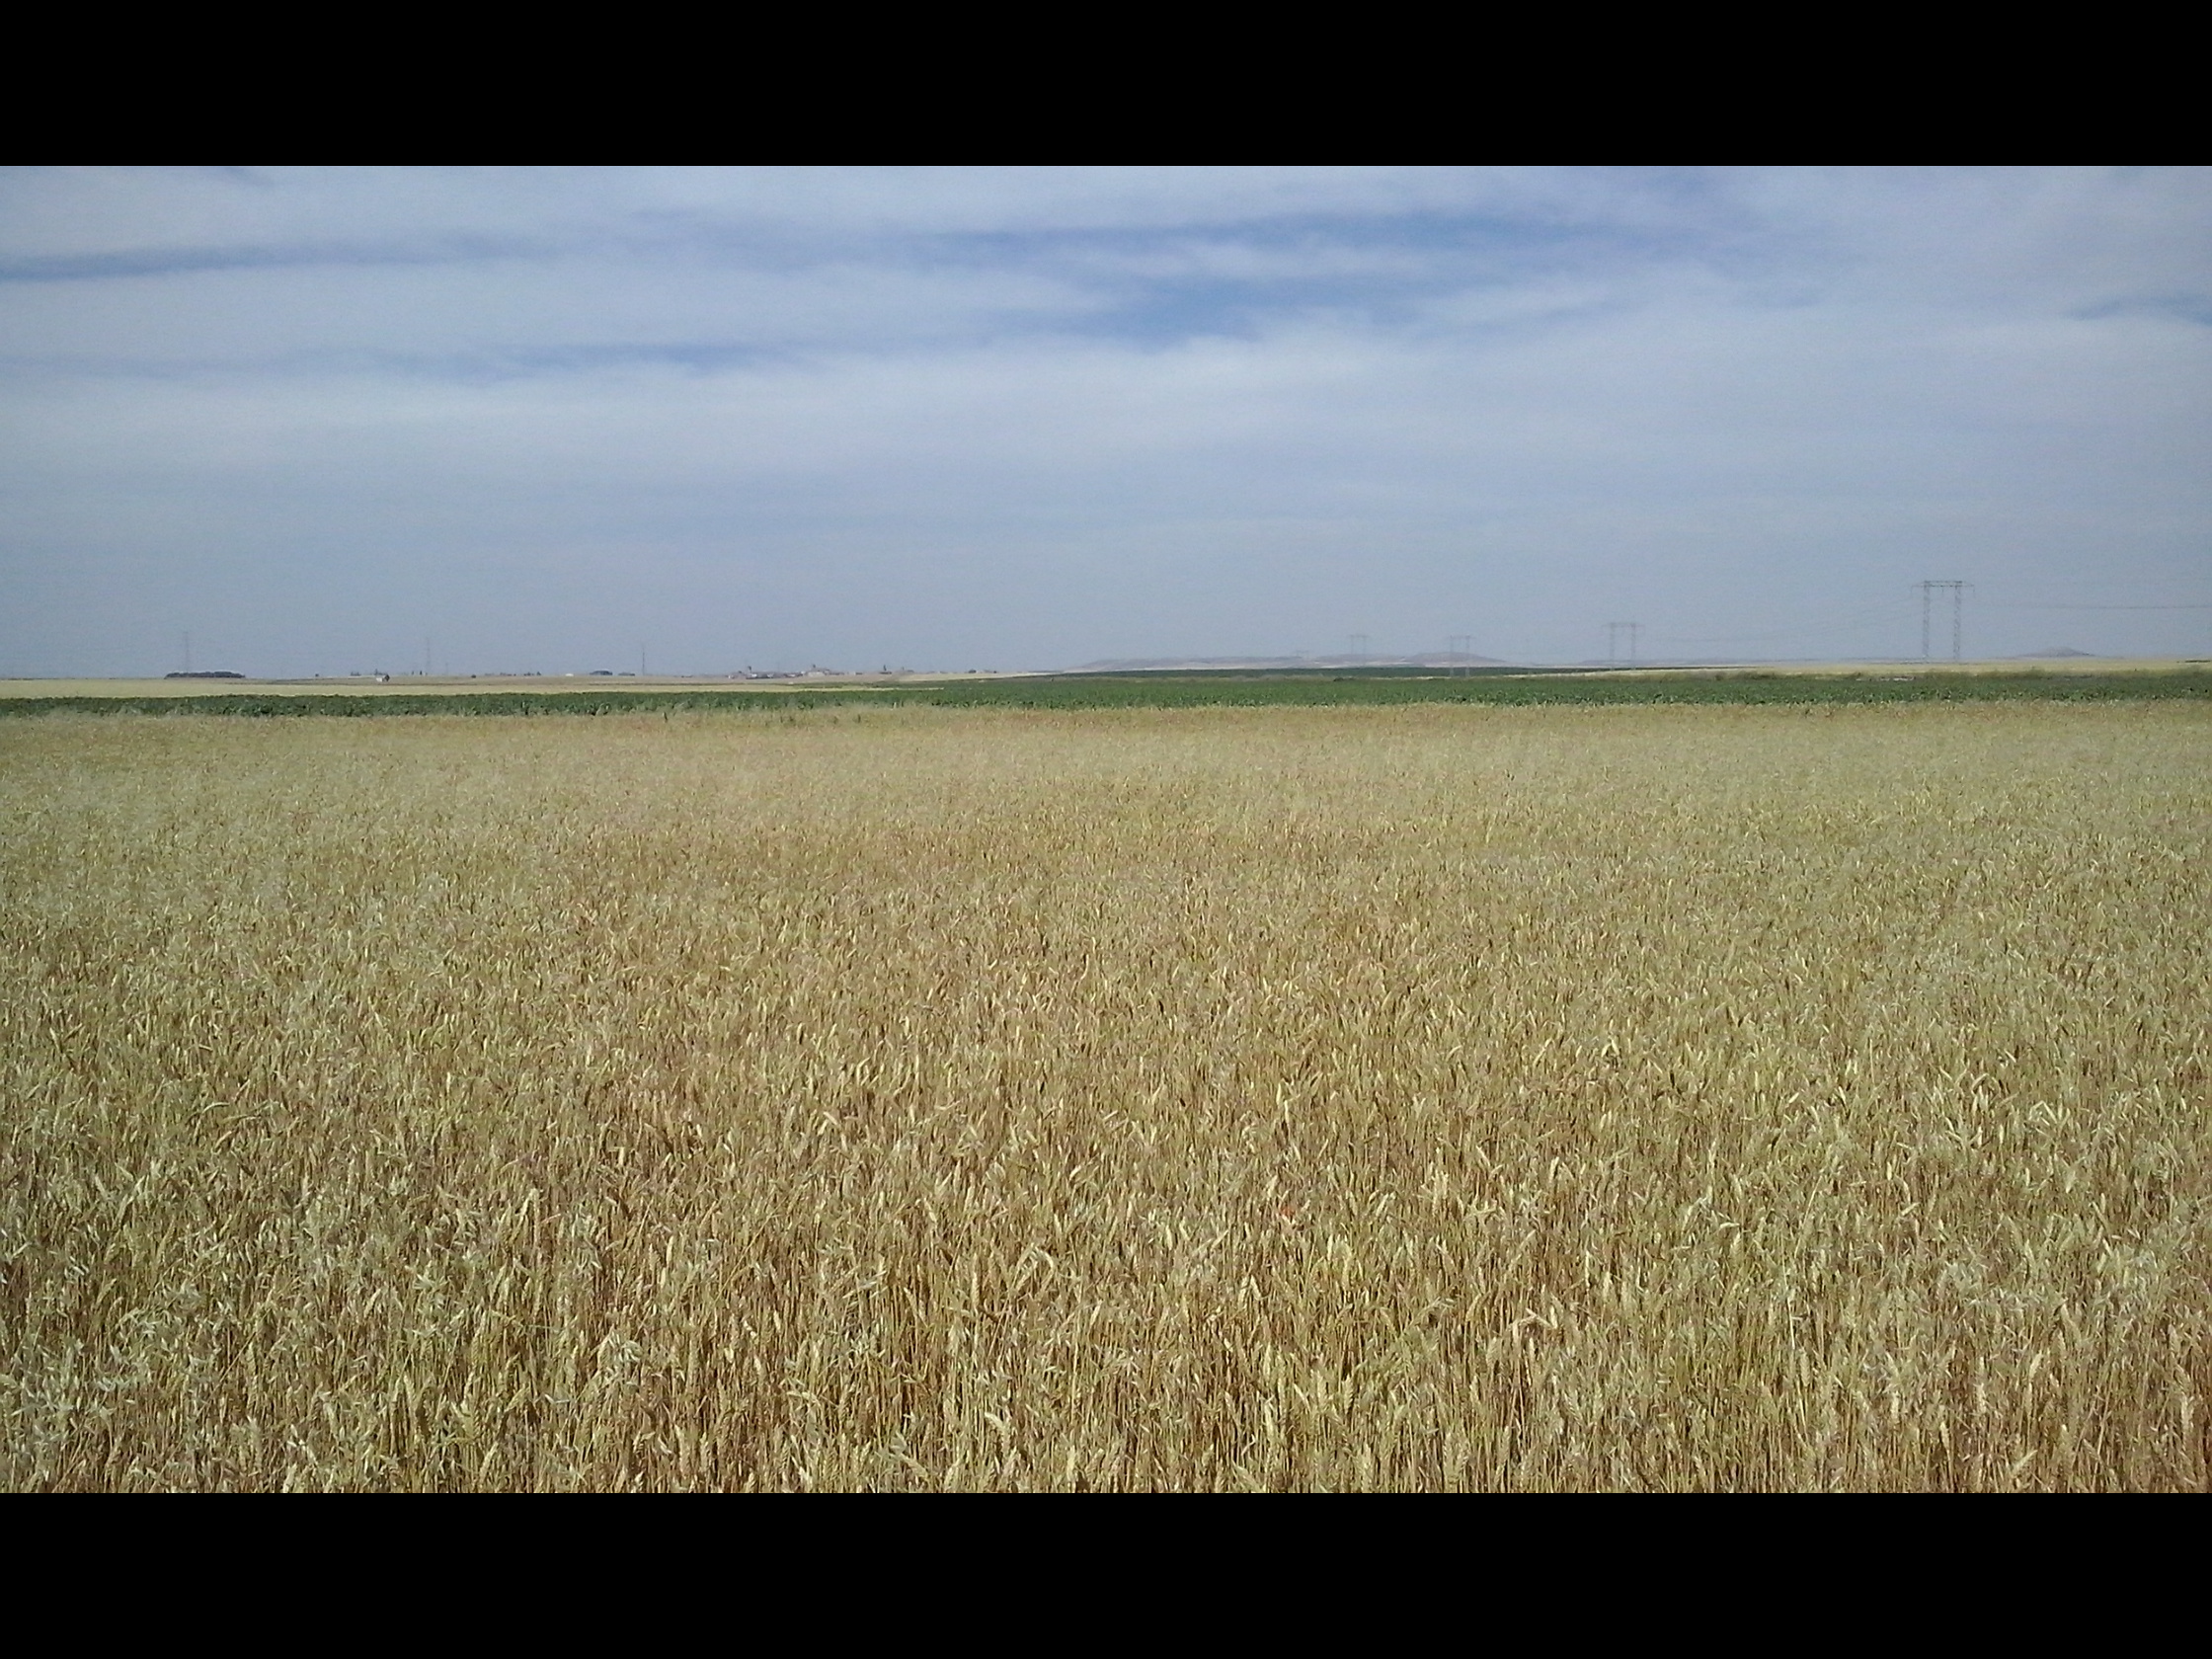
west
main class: Cropland
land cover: Common wheat
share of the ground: > 75 %
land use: Agriculture (excluding fallow land and kitchen gardens)
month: July
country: ES
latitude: 41.5516
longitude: -5.0967
